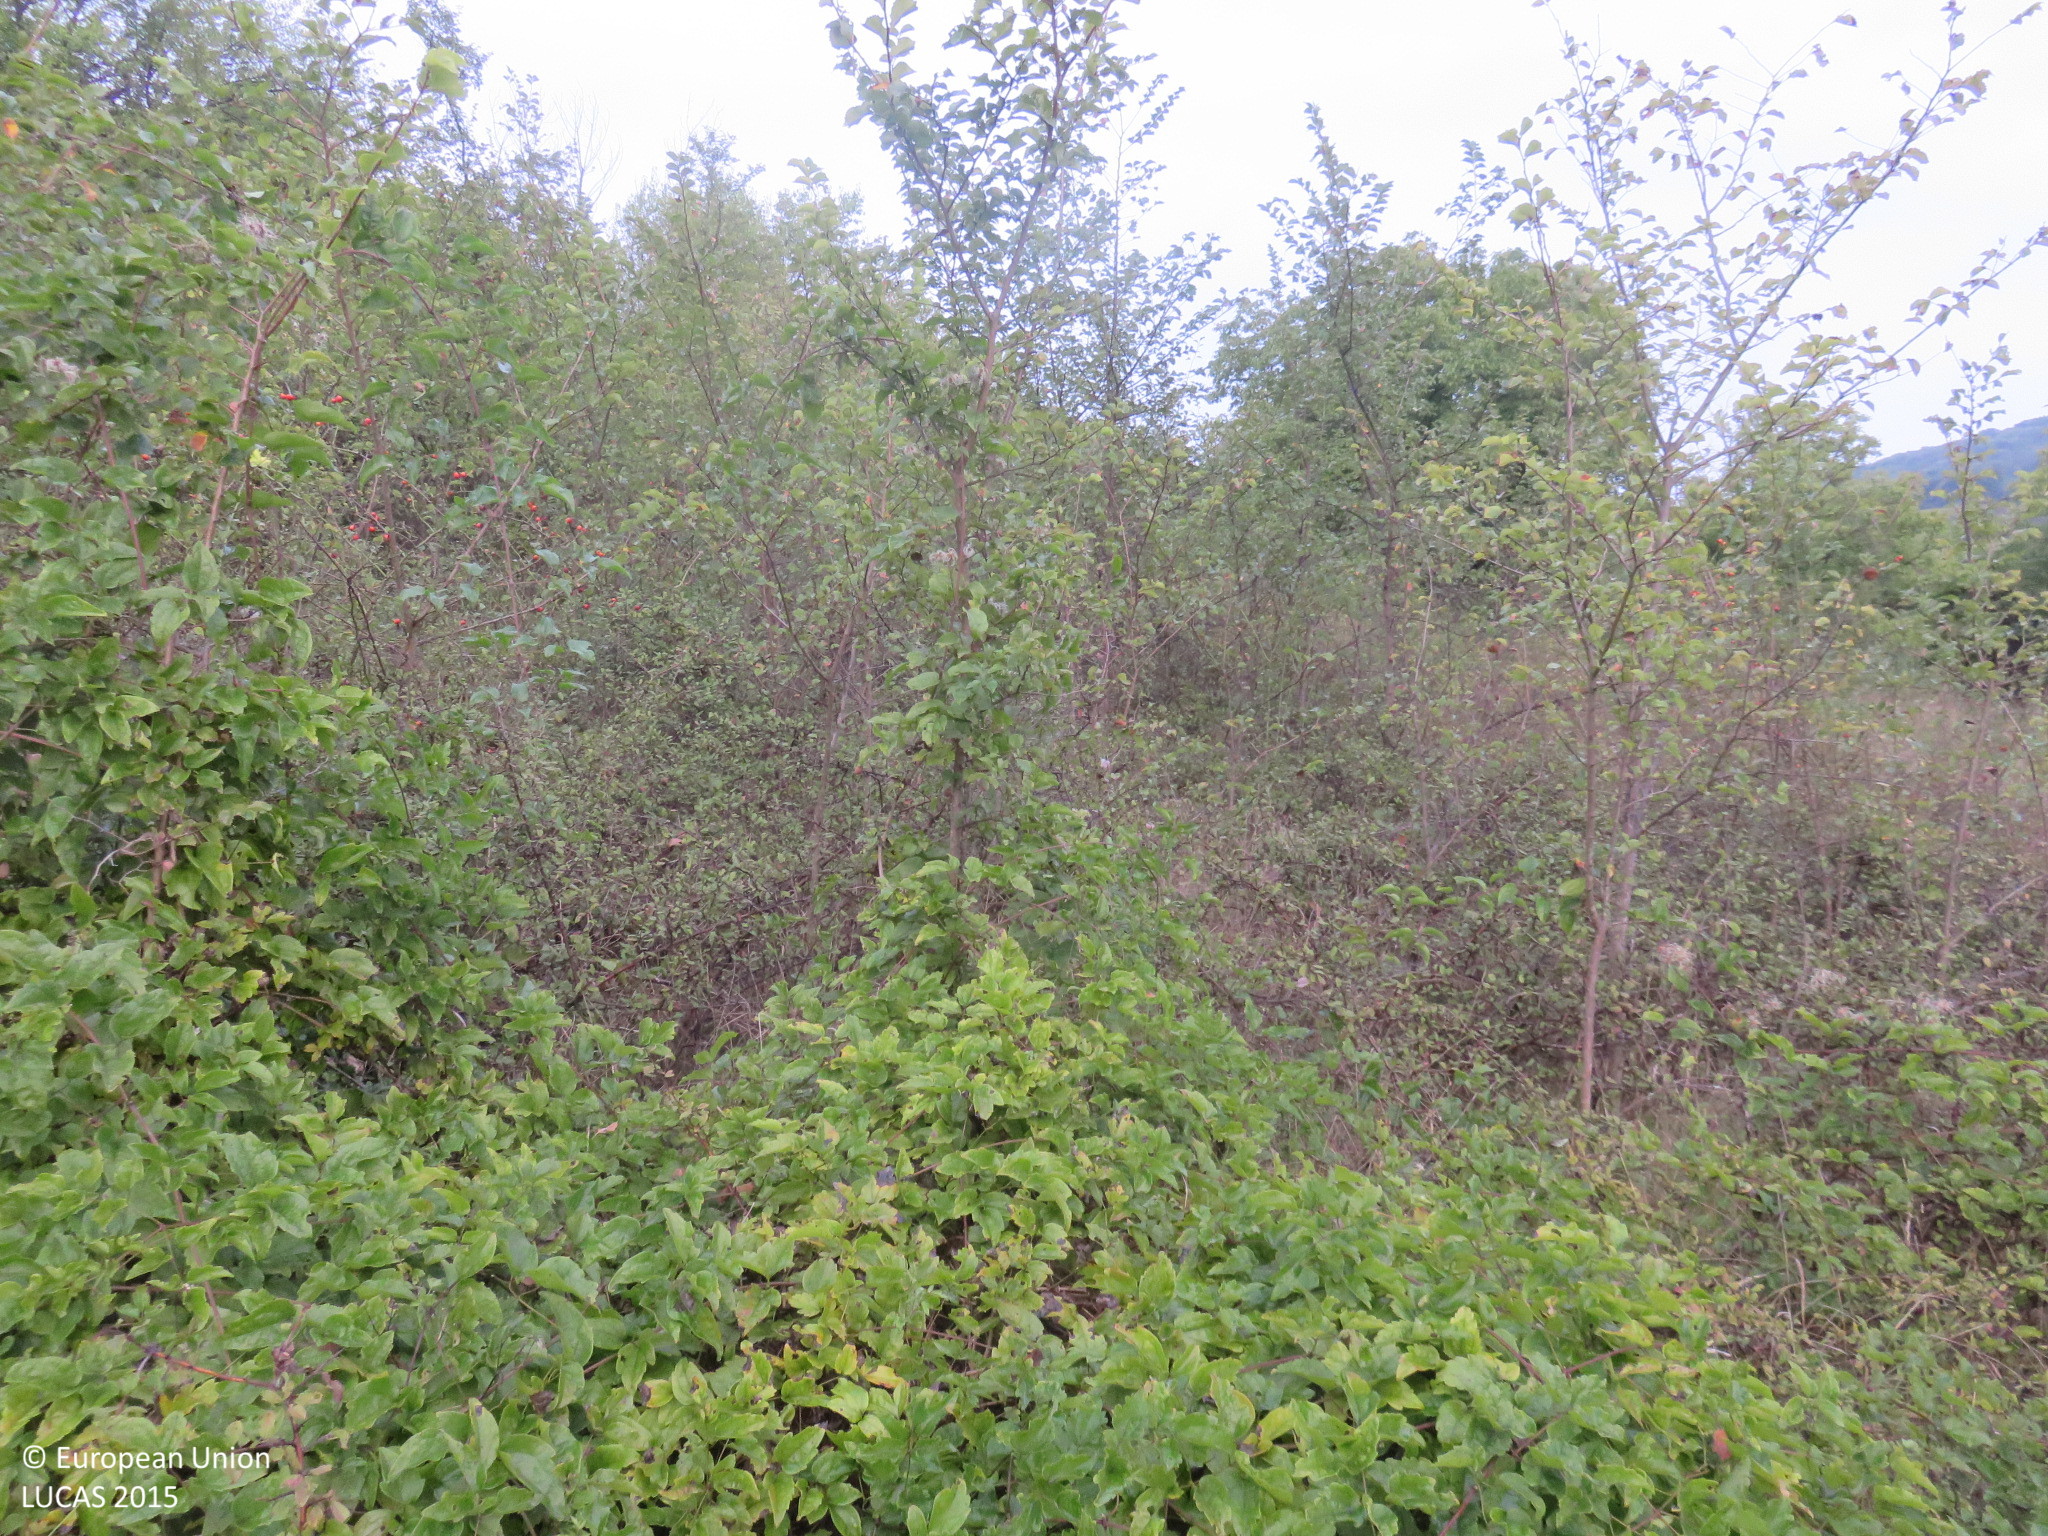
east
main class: Shrubland
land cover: Shrubland with sparse tree cover
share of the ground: > 75 %
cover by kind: shrubs 95 %, broadleaved forest trees 5 %
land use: Abandoned areas
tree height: < 5 m
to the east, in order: Shrubland with sparse tree cover; Broadleaved woodland; Shrubland with sparse tree cover; Broadleaved woodland
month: September
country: BG
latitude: 43.1882
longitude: 24.8173
